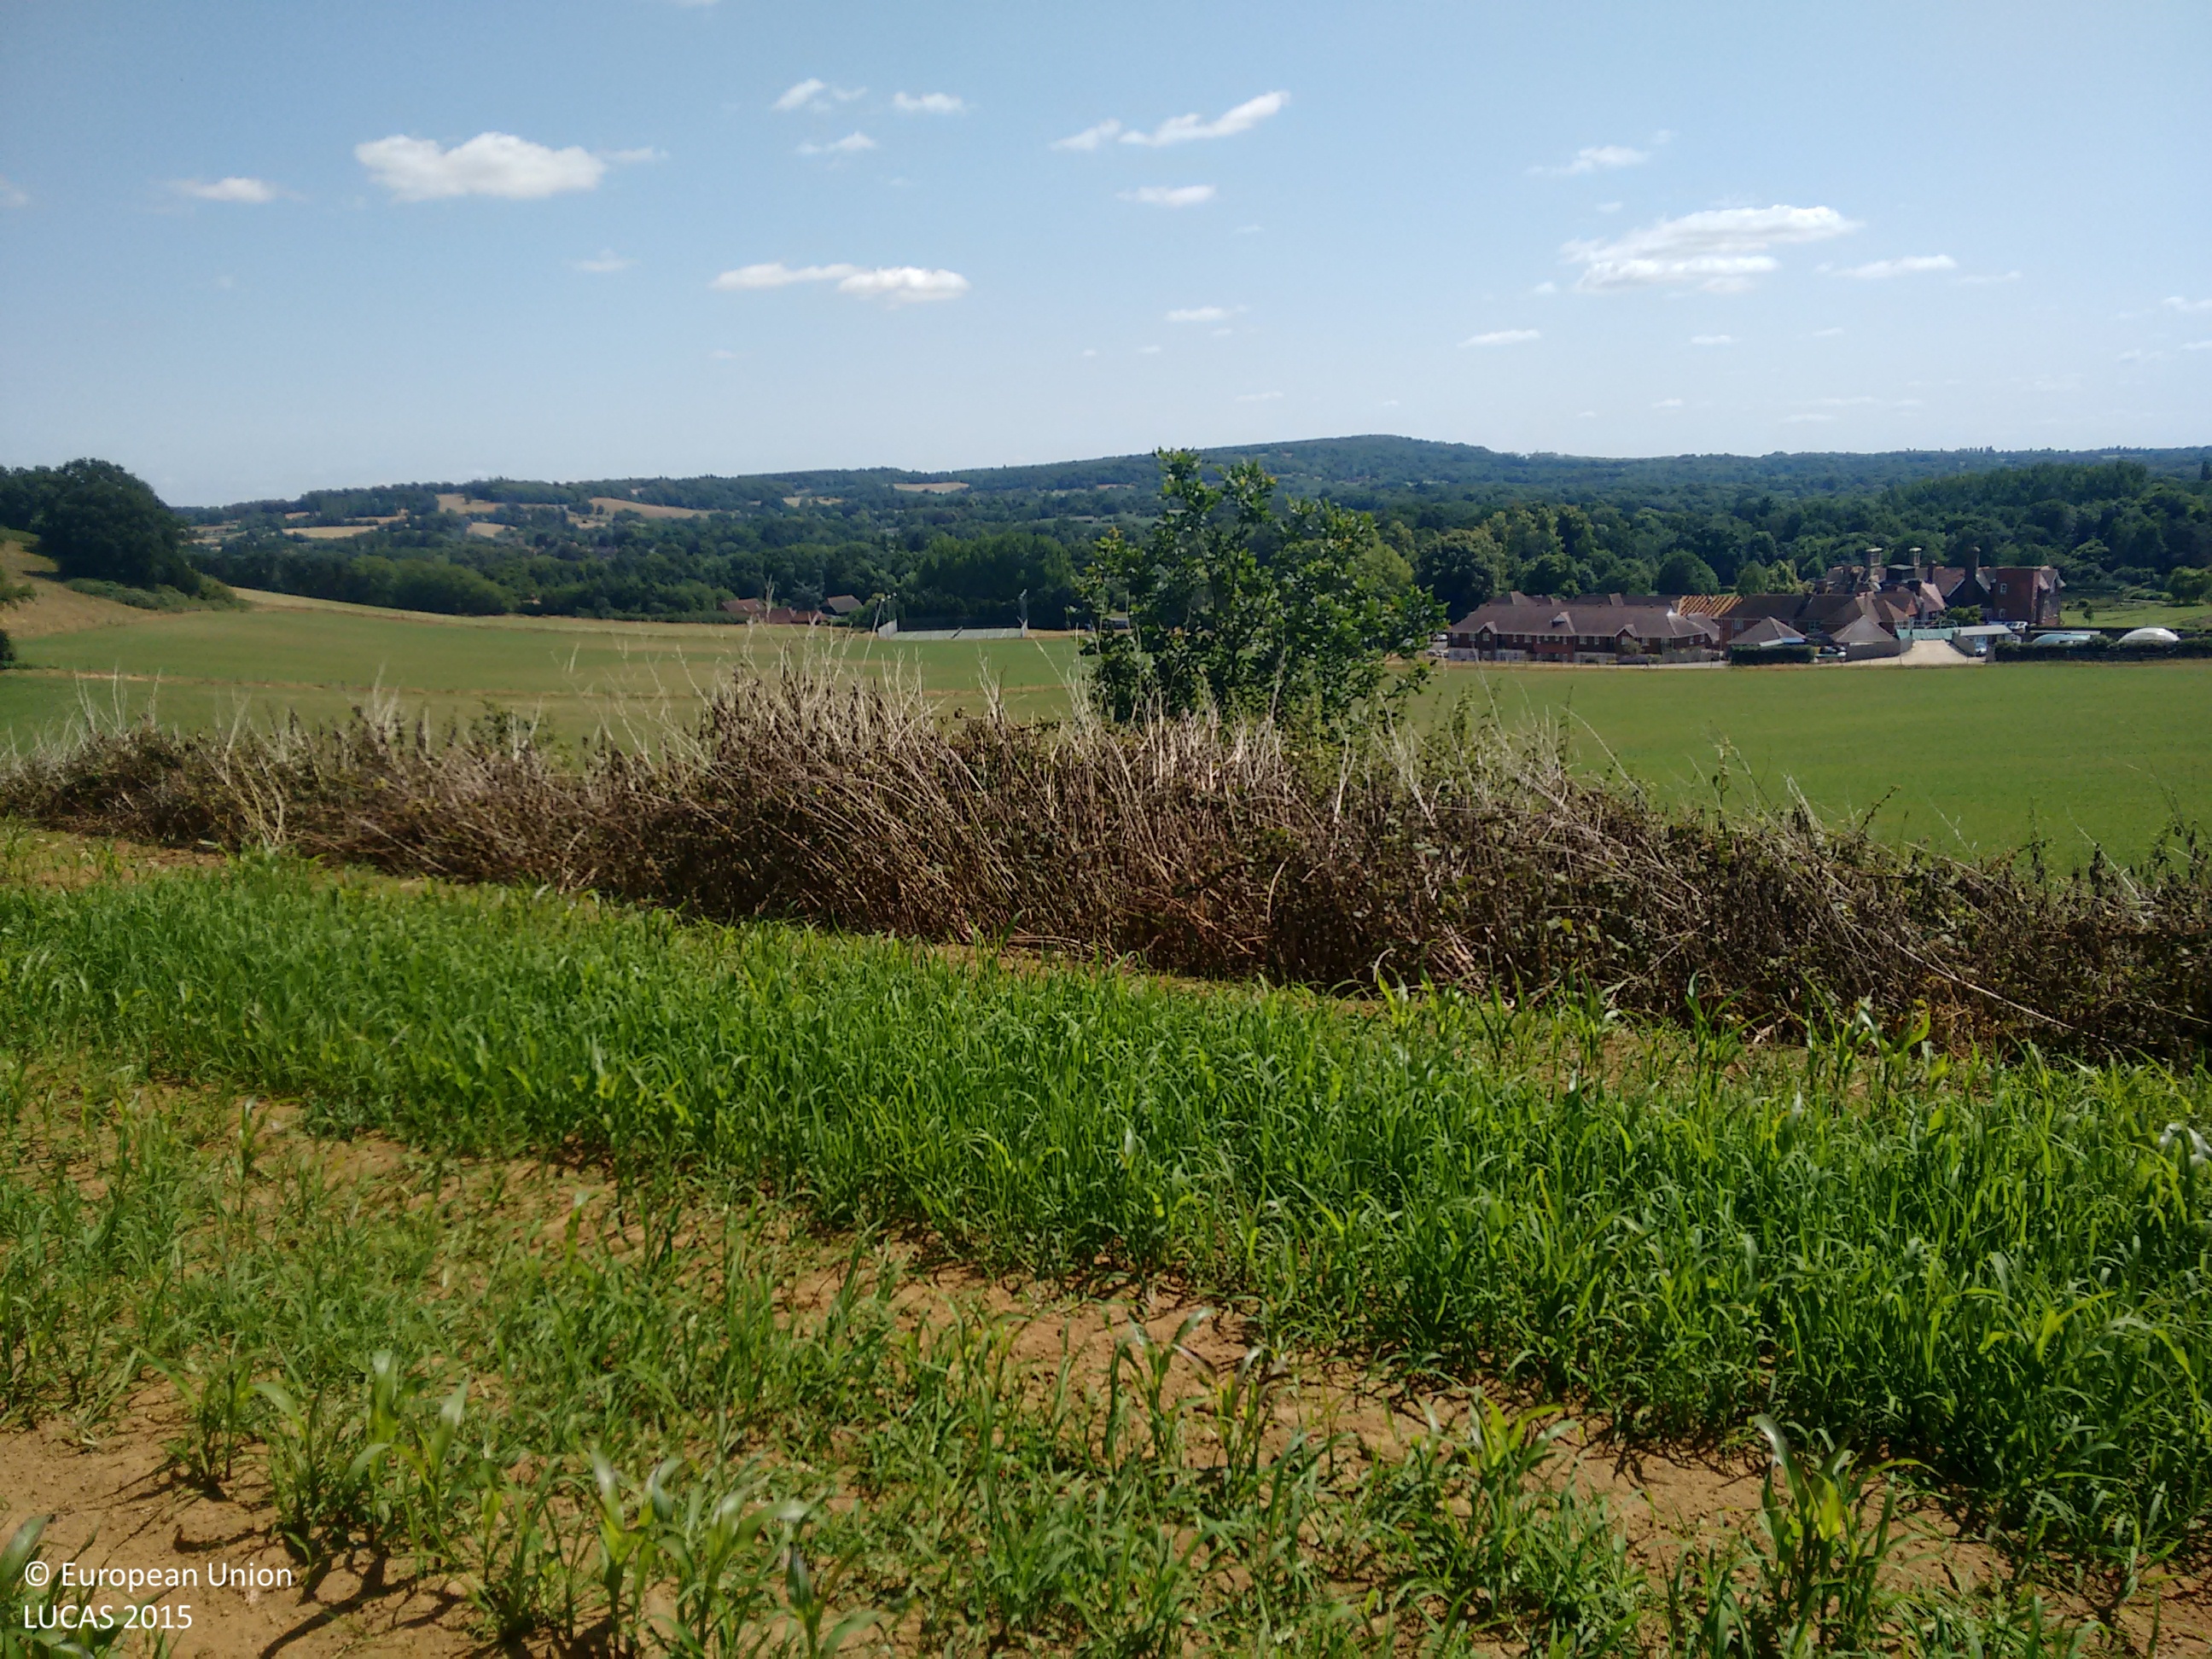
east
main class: Cropland
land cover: Maize
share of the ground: 10 - 25 %
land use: Agriculture (excluding fallow land and kitchen gardens)
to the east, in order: Maize; Managed hedges; Grassland without tree/shrub cover; Fences; Temporary grasslands
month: July
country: GB
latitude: 51.1802
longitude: -0.5534
